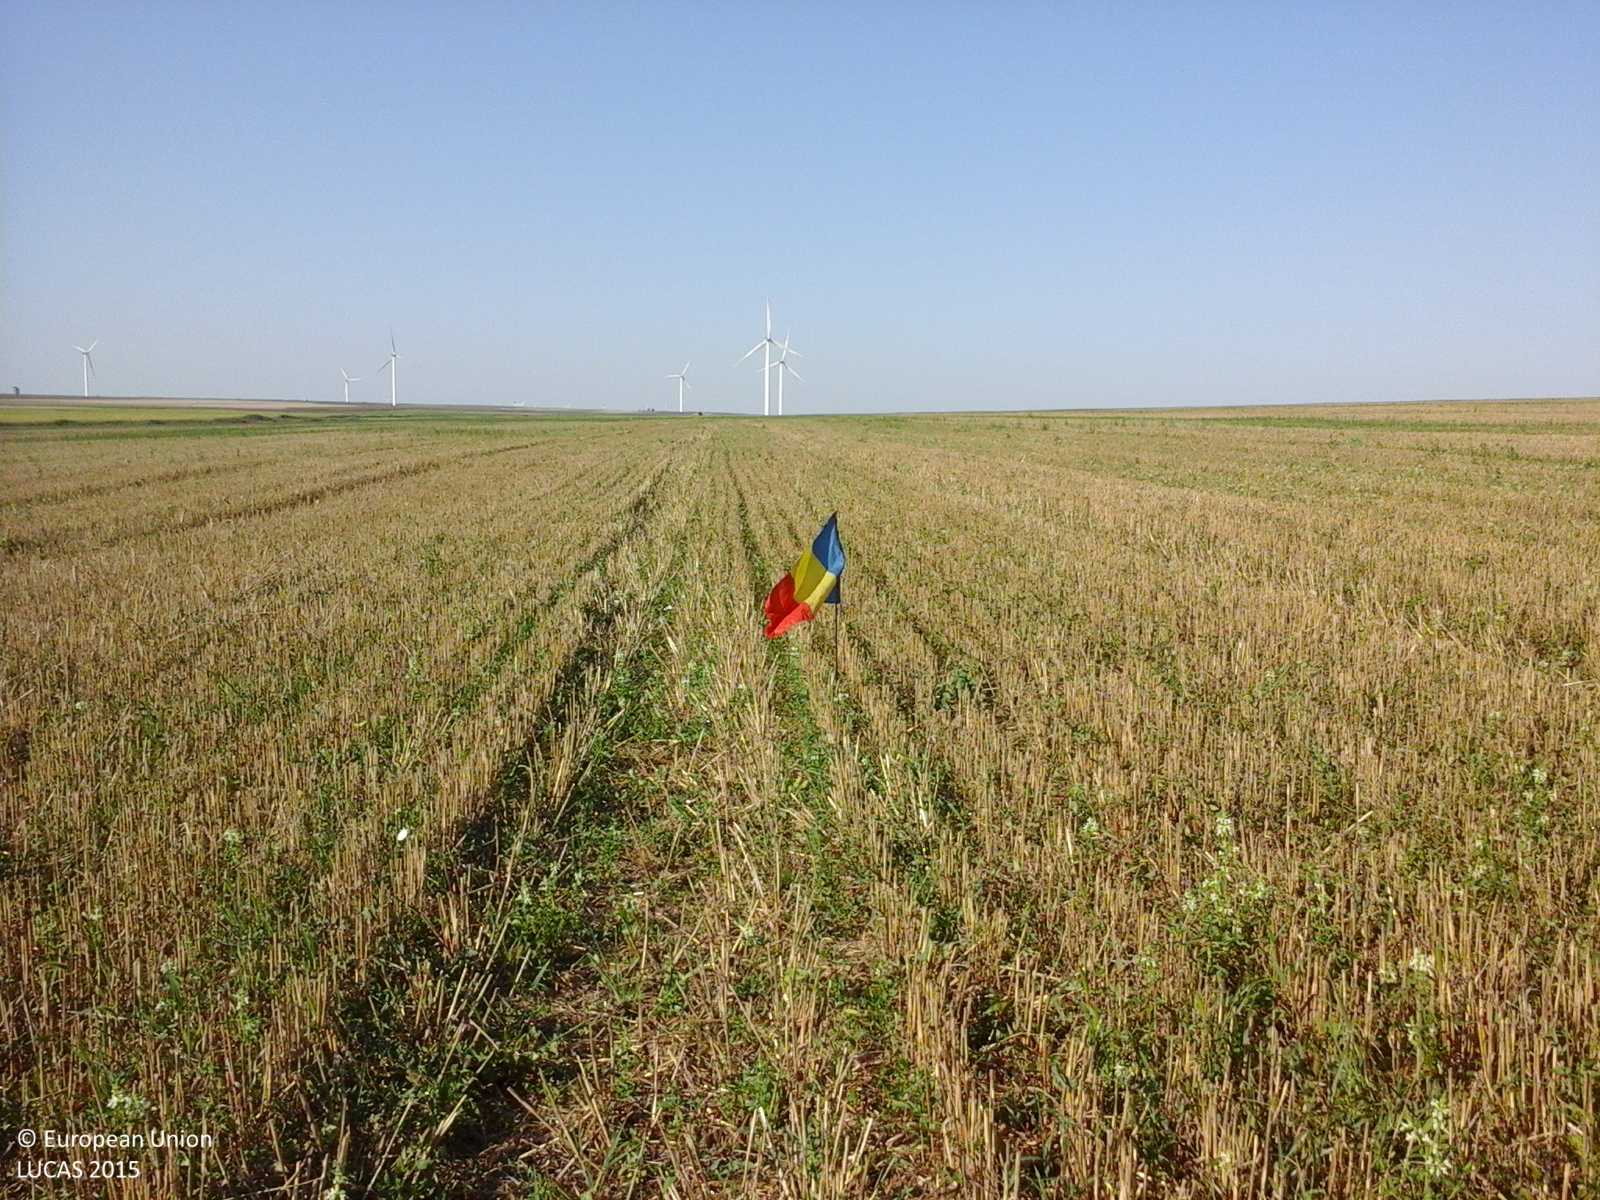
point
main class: Cropland
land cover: Common wheat
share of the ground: > 75 %
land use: Agriculture (excluding fallow land and kitchen gardens)
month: August
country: RO
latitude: 44.3369
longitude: 28.3660
